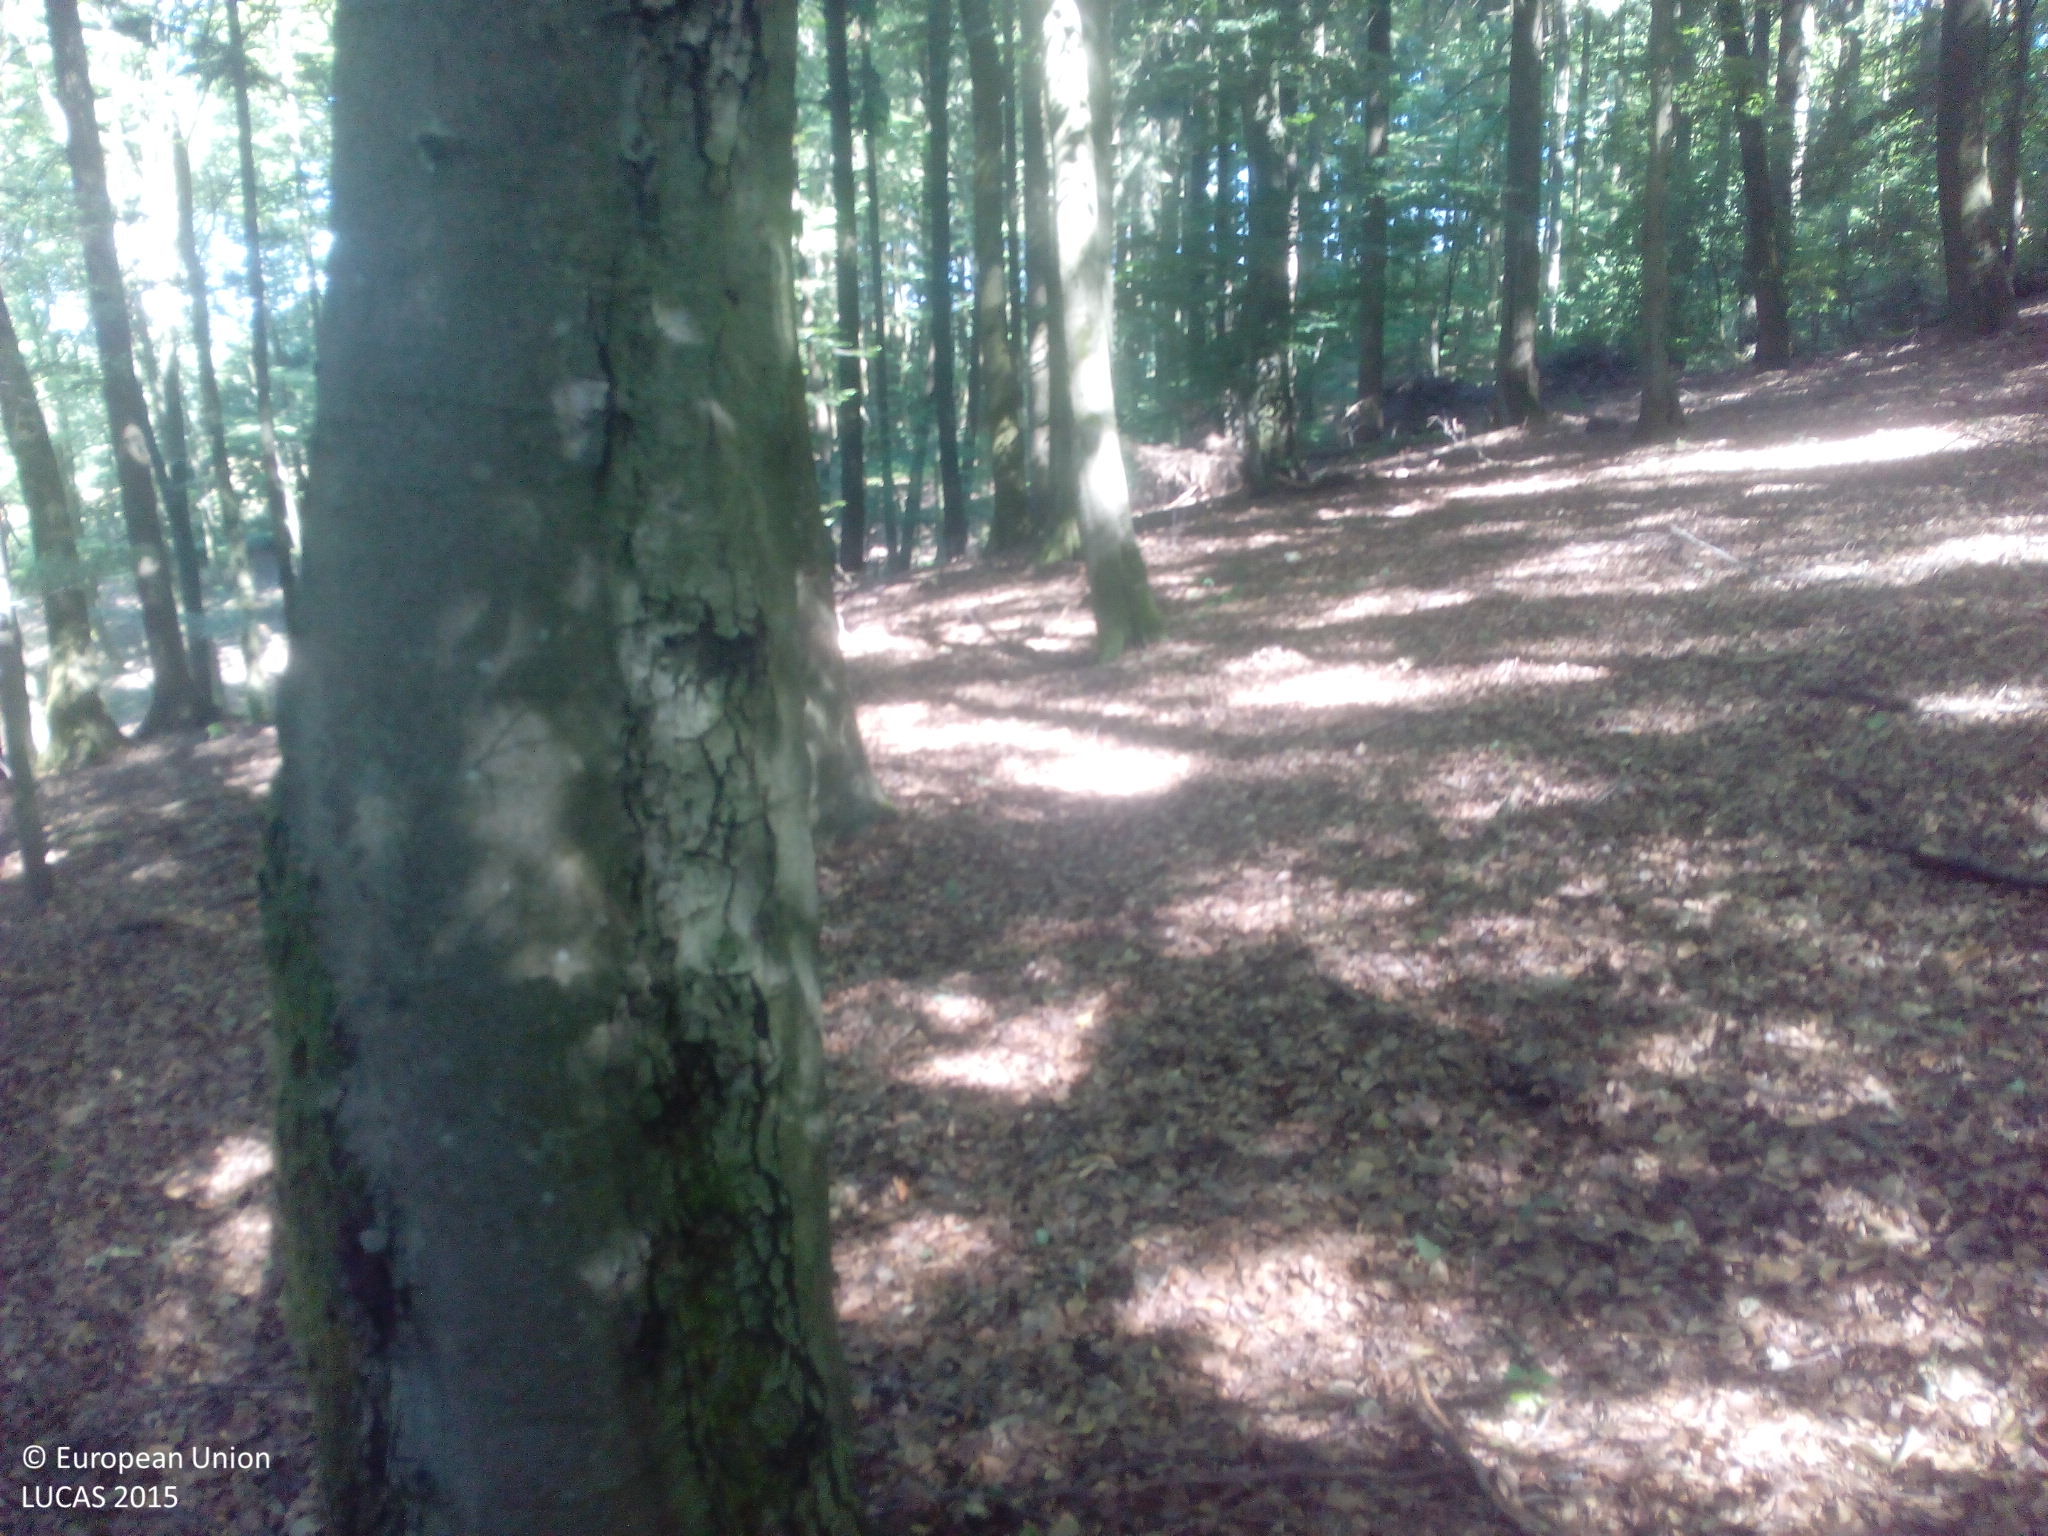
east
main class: Woodland
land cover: Broadleaved woodland
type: mesophytic deciduous forest
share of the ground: > 75 %
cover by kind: broadleaved forest trees 100 %
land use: Forestry
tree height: > 5 m
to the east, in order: Broadleaved woodland; Spruce dominated coniferous woodland; Broadleaved woodland; Spruce dominated coniferous woodland; Grassland without tree/shrub cover; Rape and turnip rape
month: July
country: DE
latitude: 49.4633
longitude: 7.0890
